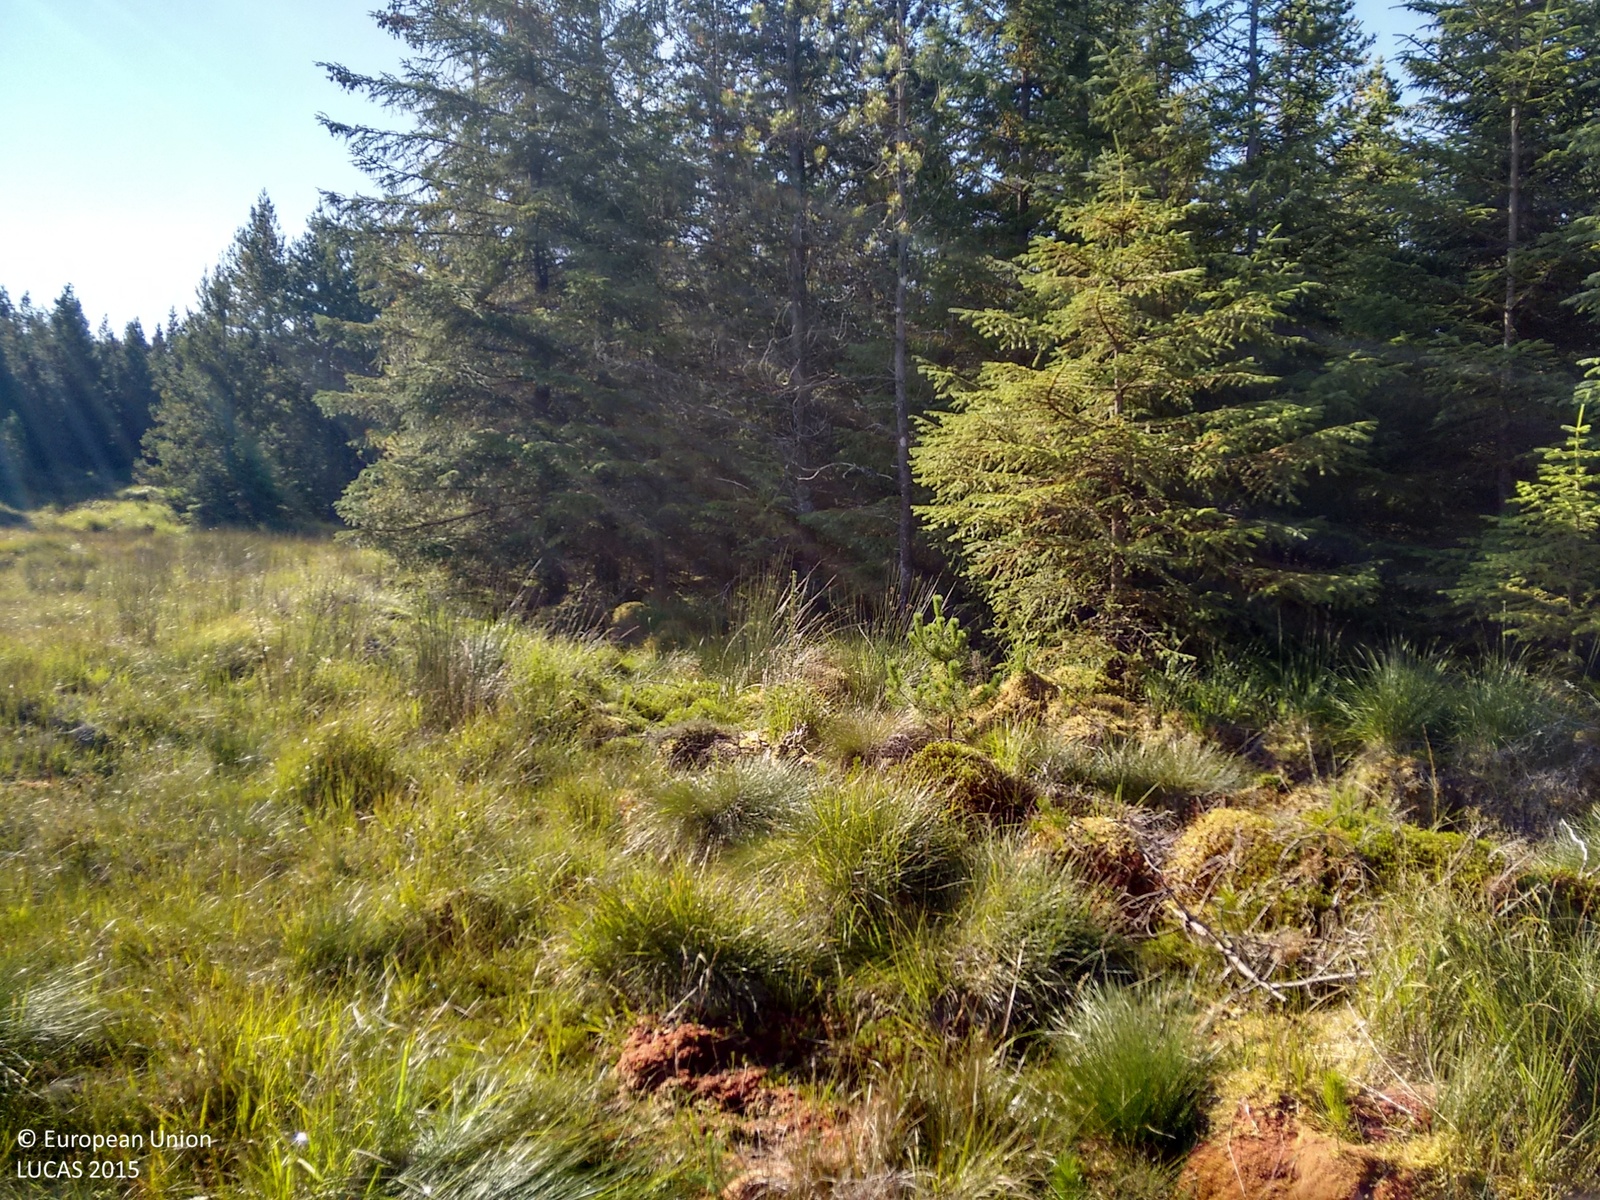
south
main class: Grassland
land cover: Grassland without tree/shrub cover
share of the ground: > 75 %
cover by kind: herbaceous plants 90 %, lichens and mosses 10 %
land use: Forestry
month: September
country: GB
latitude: 58.0127
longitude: -4.8377
